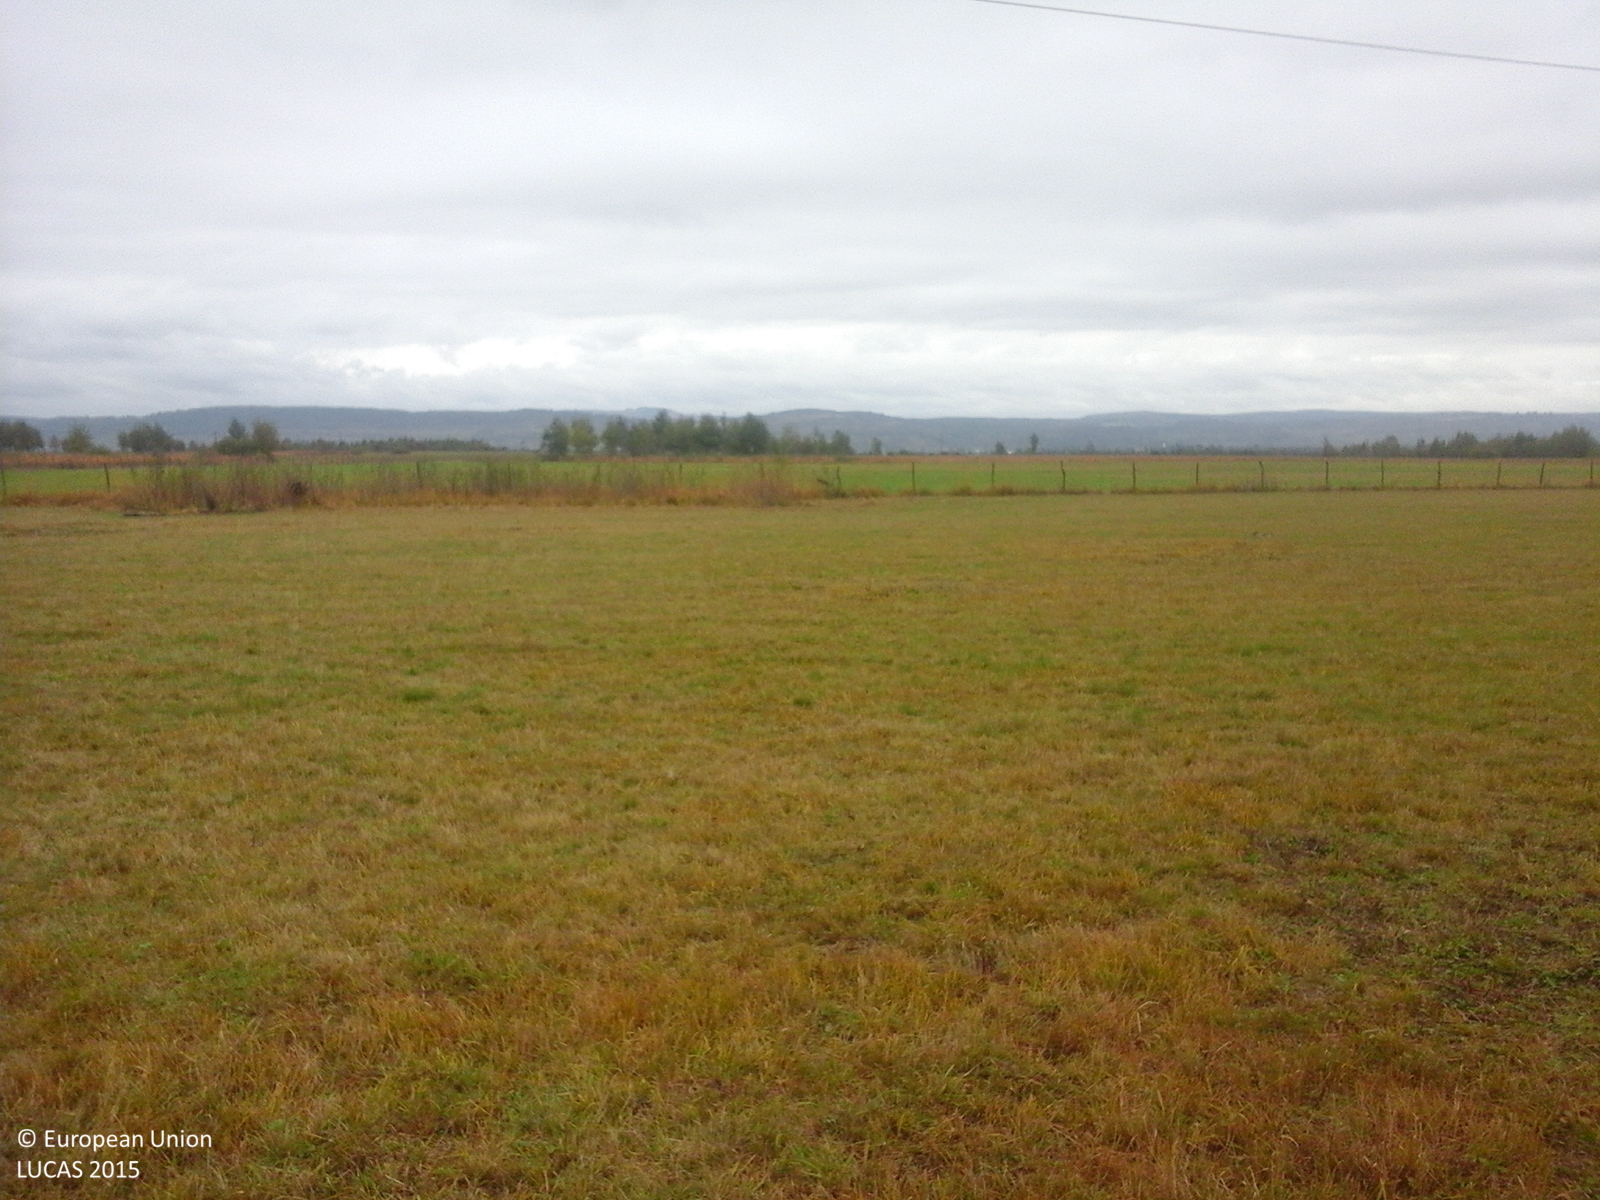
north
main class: Grassland
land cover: Grassland without tree/shrub cover
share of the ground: > 75 %
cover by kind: herbaceous plants 100 %
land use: Agriculture (excluding fallow land and kitchen gardens)
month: October
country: RO
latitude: 45.7459
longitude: 24.5951
